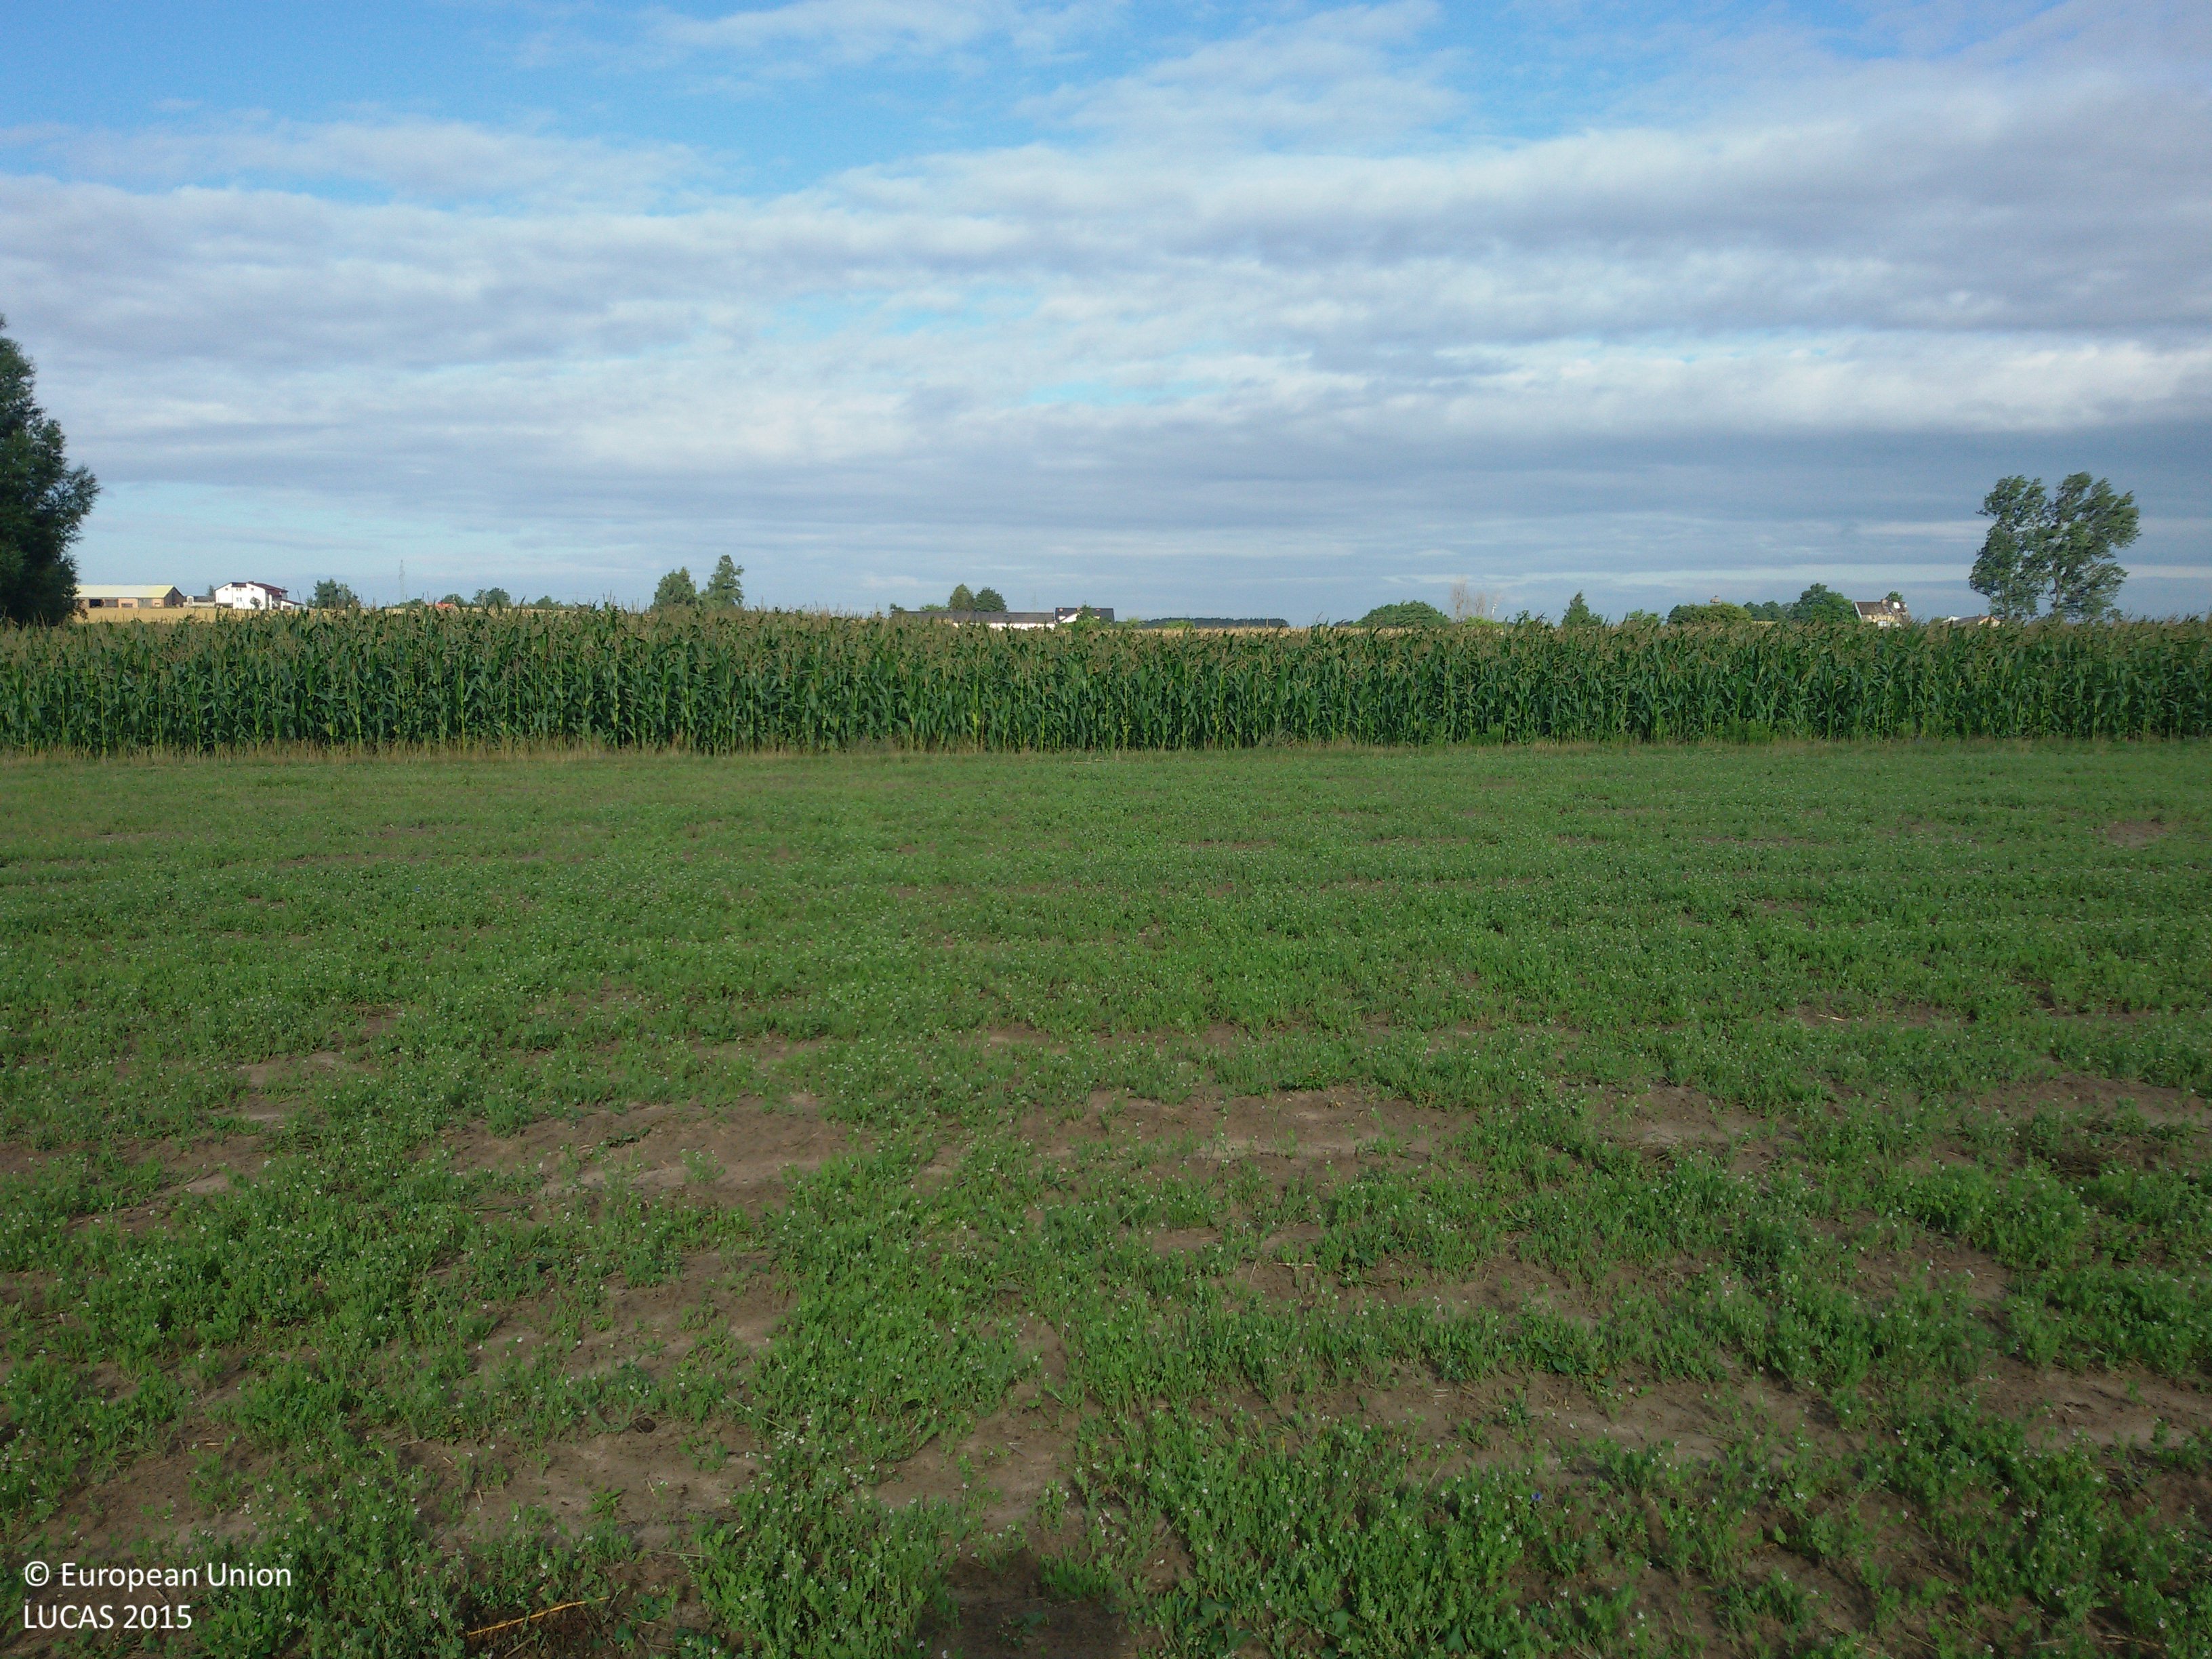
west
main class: Cropland
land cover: Dry pulses
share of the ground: > 75 %
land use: Agriculture (excluding fallow land and kitchen gardens)
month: July
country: PL
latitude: 52.8398
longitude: 19.1243
